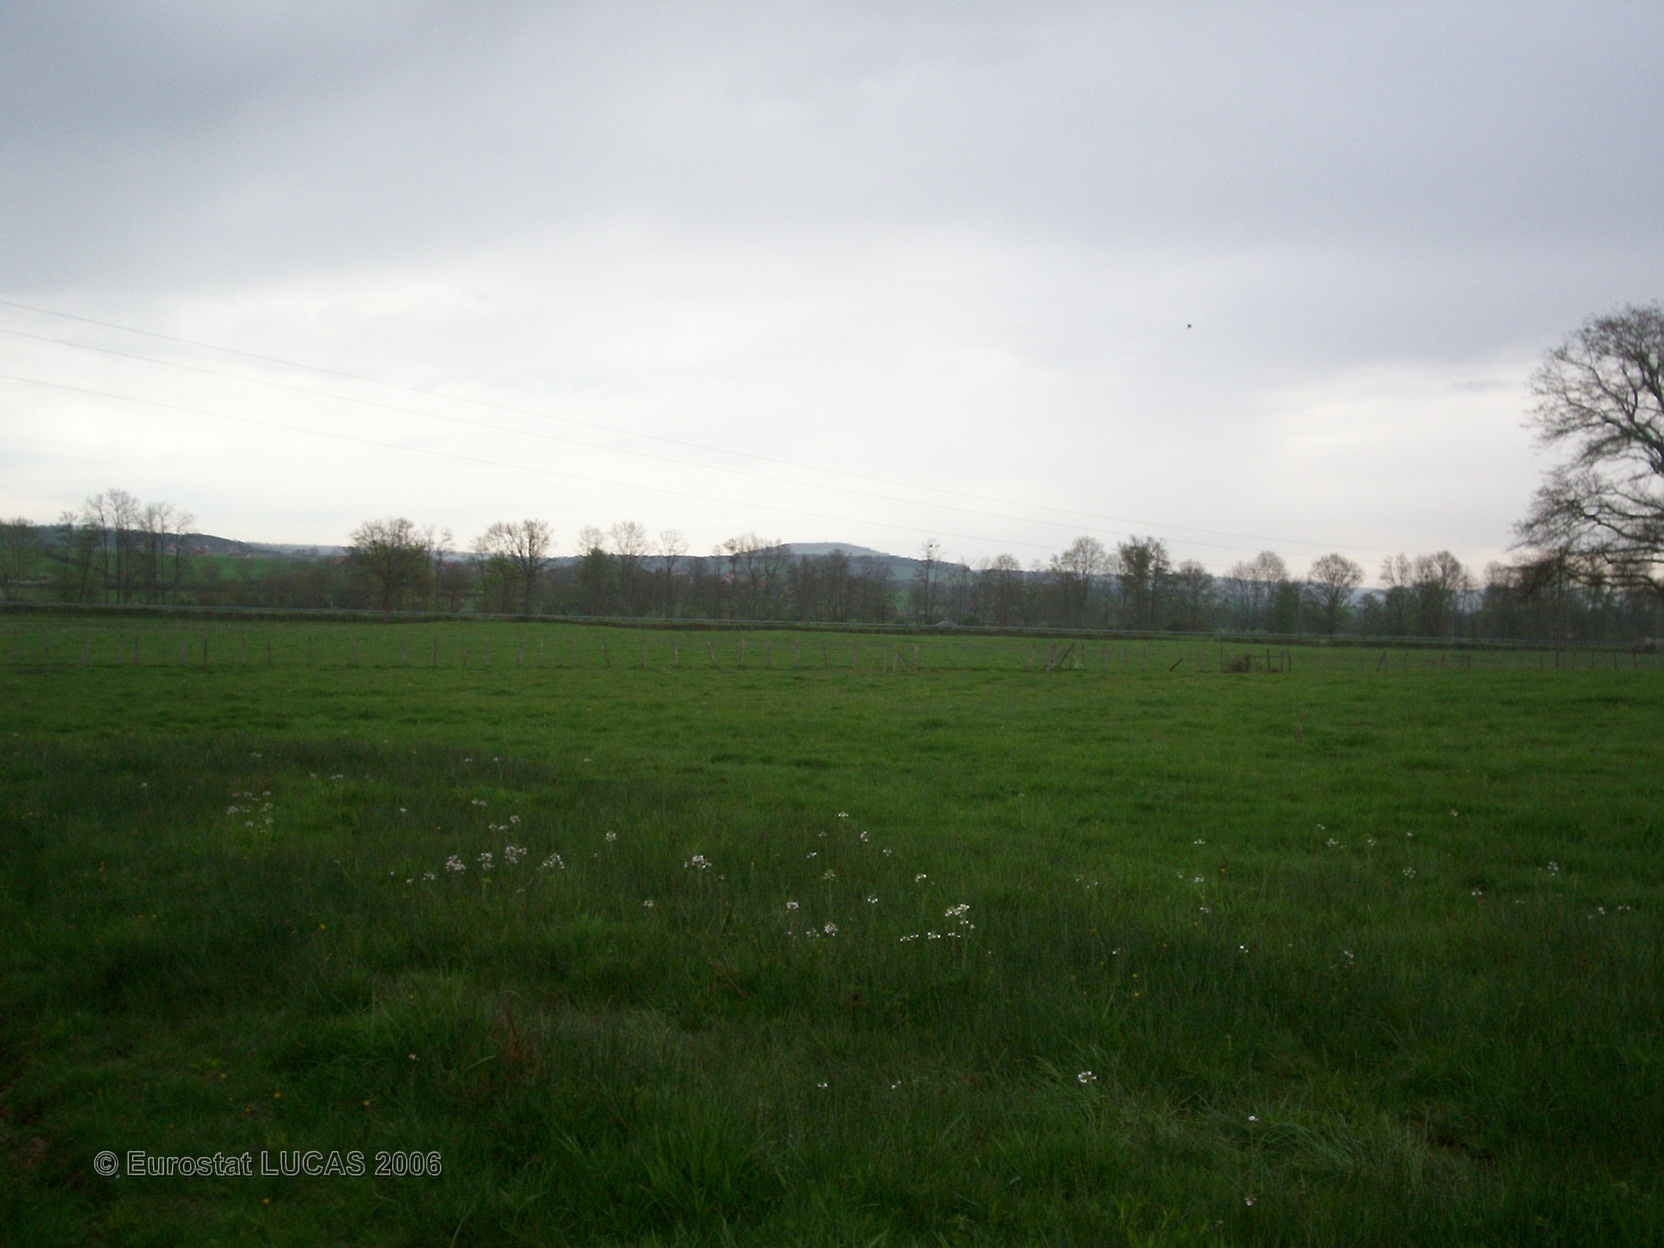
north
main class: Grassland
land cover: Grassland without tree/shrub cover
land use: Agriculture (excluding fallow land and kitchen gardens)
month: April
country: FR
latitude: 46.8291
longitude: 4.6128
